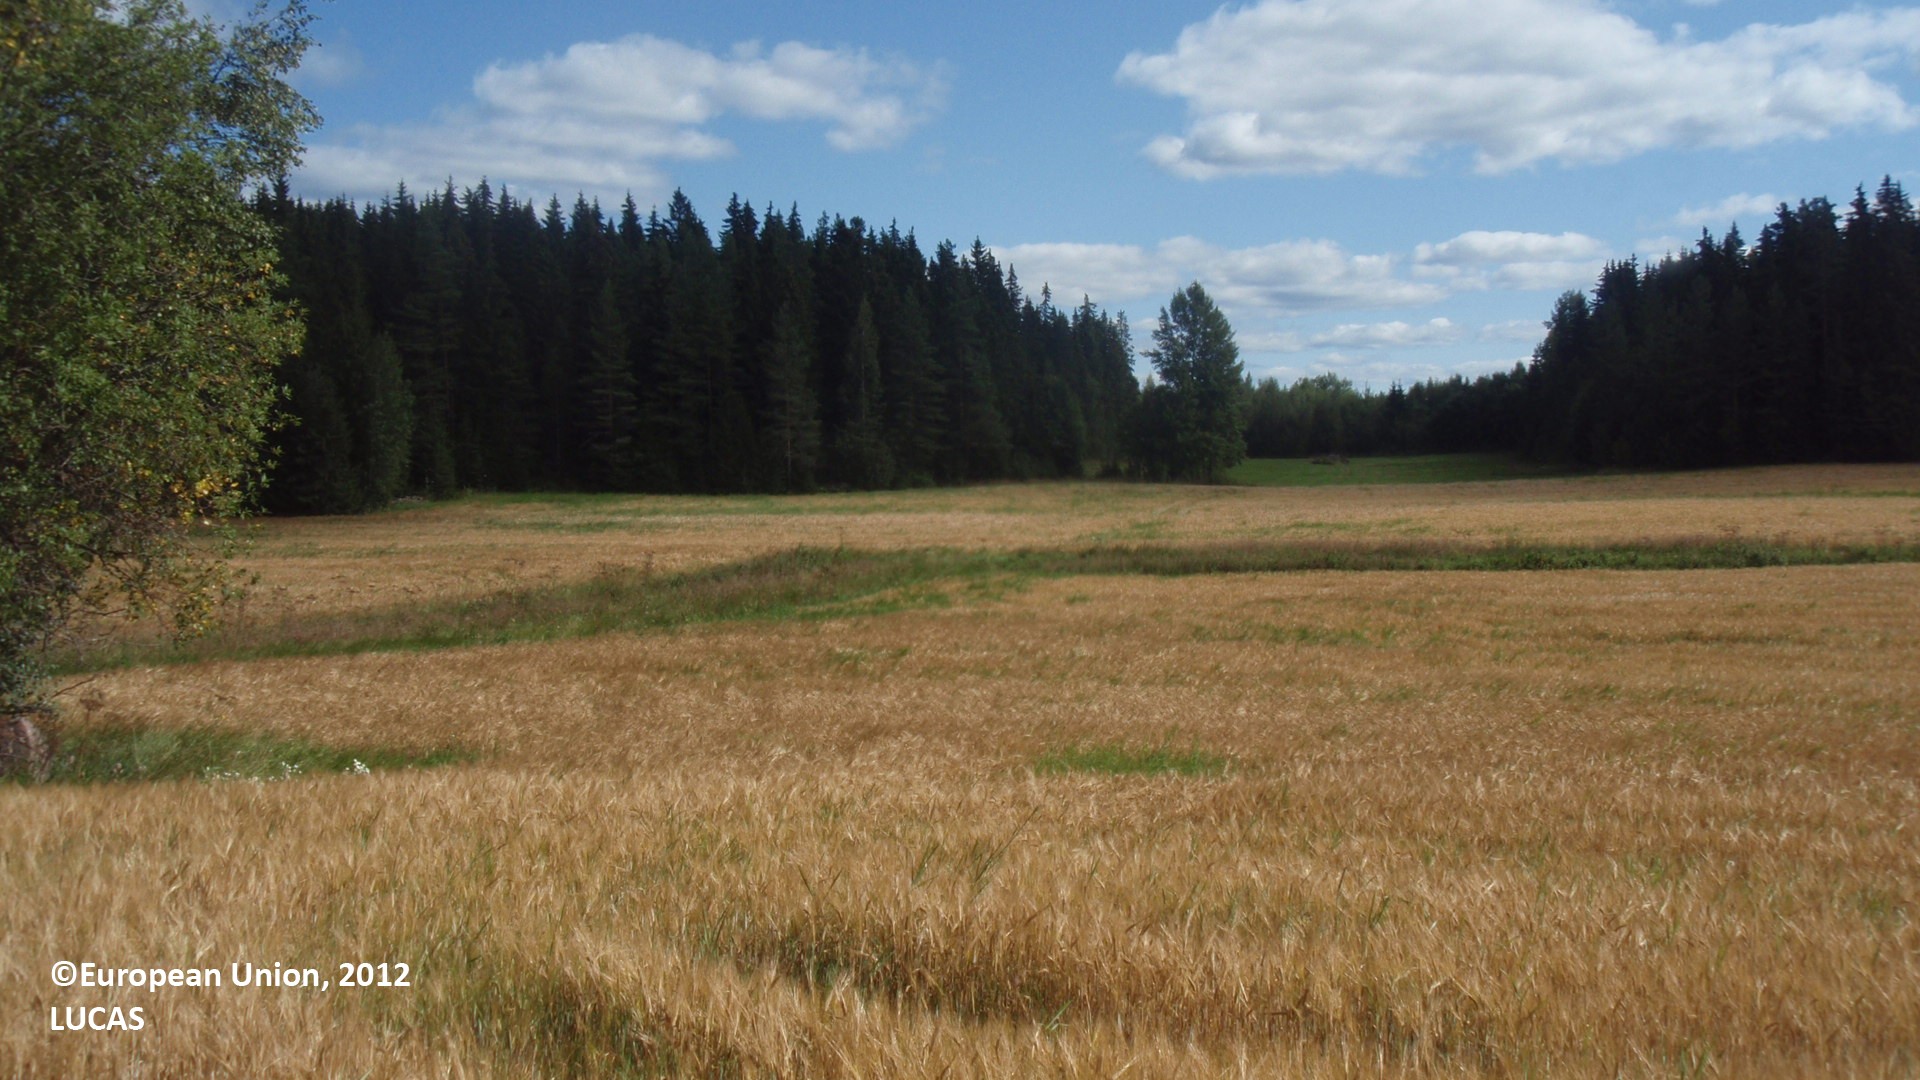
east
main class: Cropland
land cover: Barley
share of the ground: > 75 %
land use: Agriculture (excluding fallow land and kitchen gardens)
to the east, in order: Barley; Grass margins; Rock outcrops; Tracks; Spruce dominated mixed woodland; Grass margins; Oats; Spruce dominated mixed woodland
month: August
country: FI
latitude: 60.6551
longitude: 27.4334
